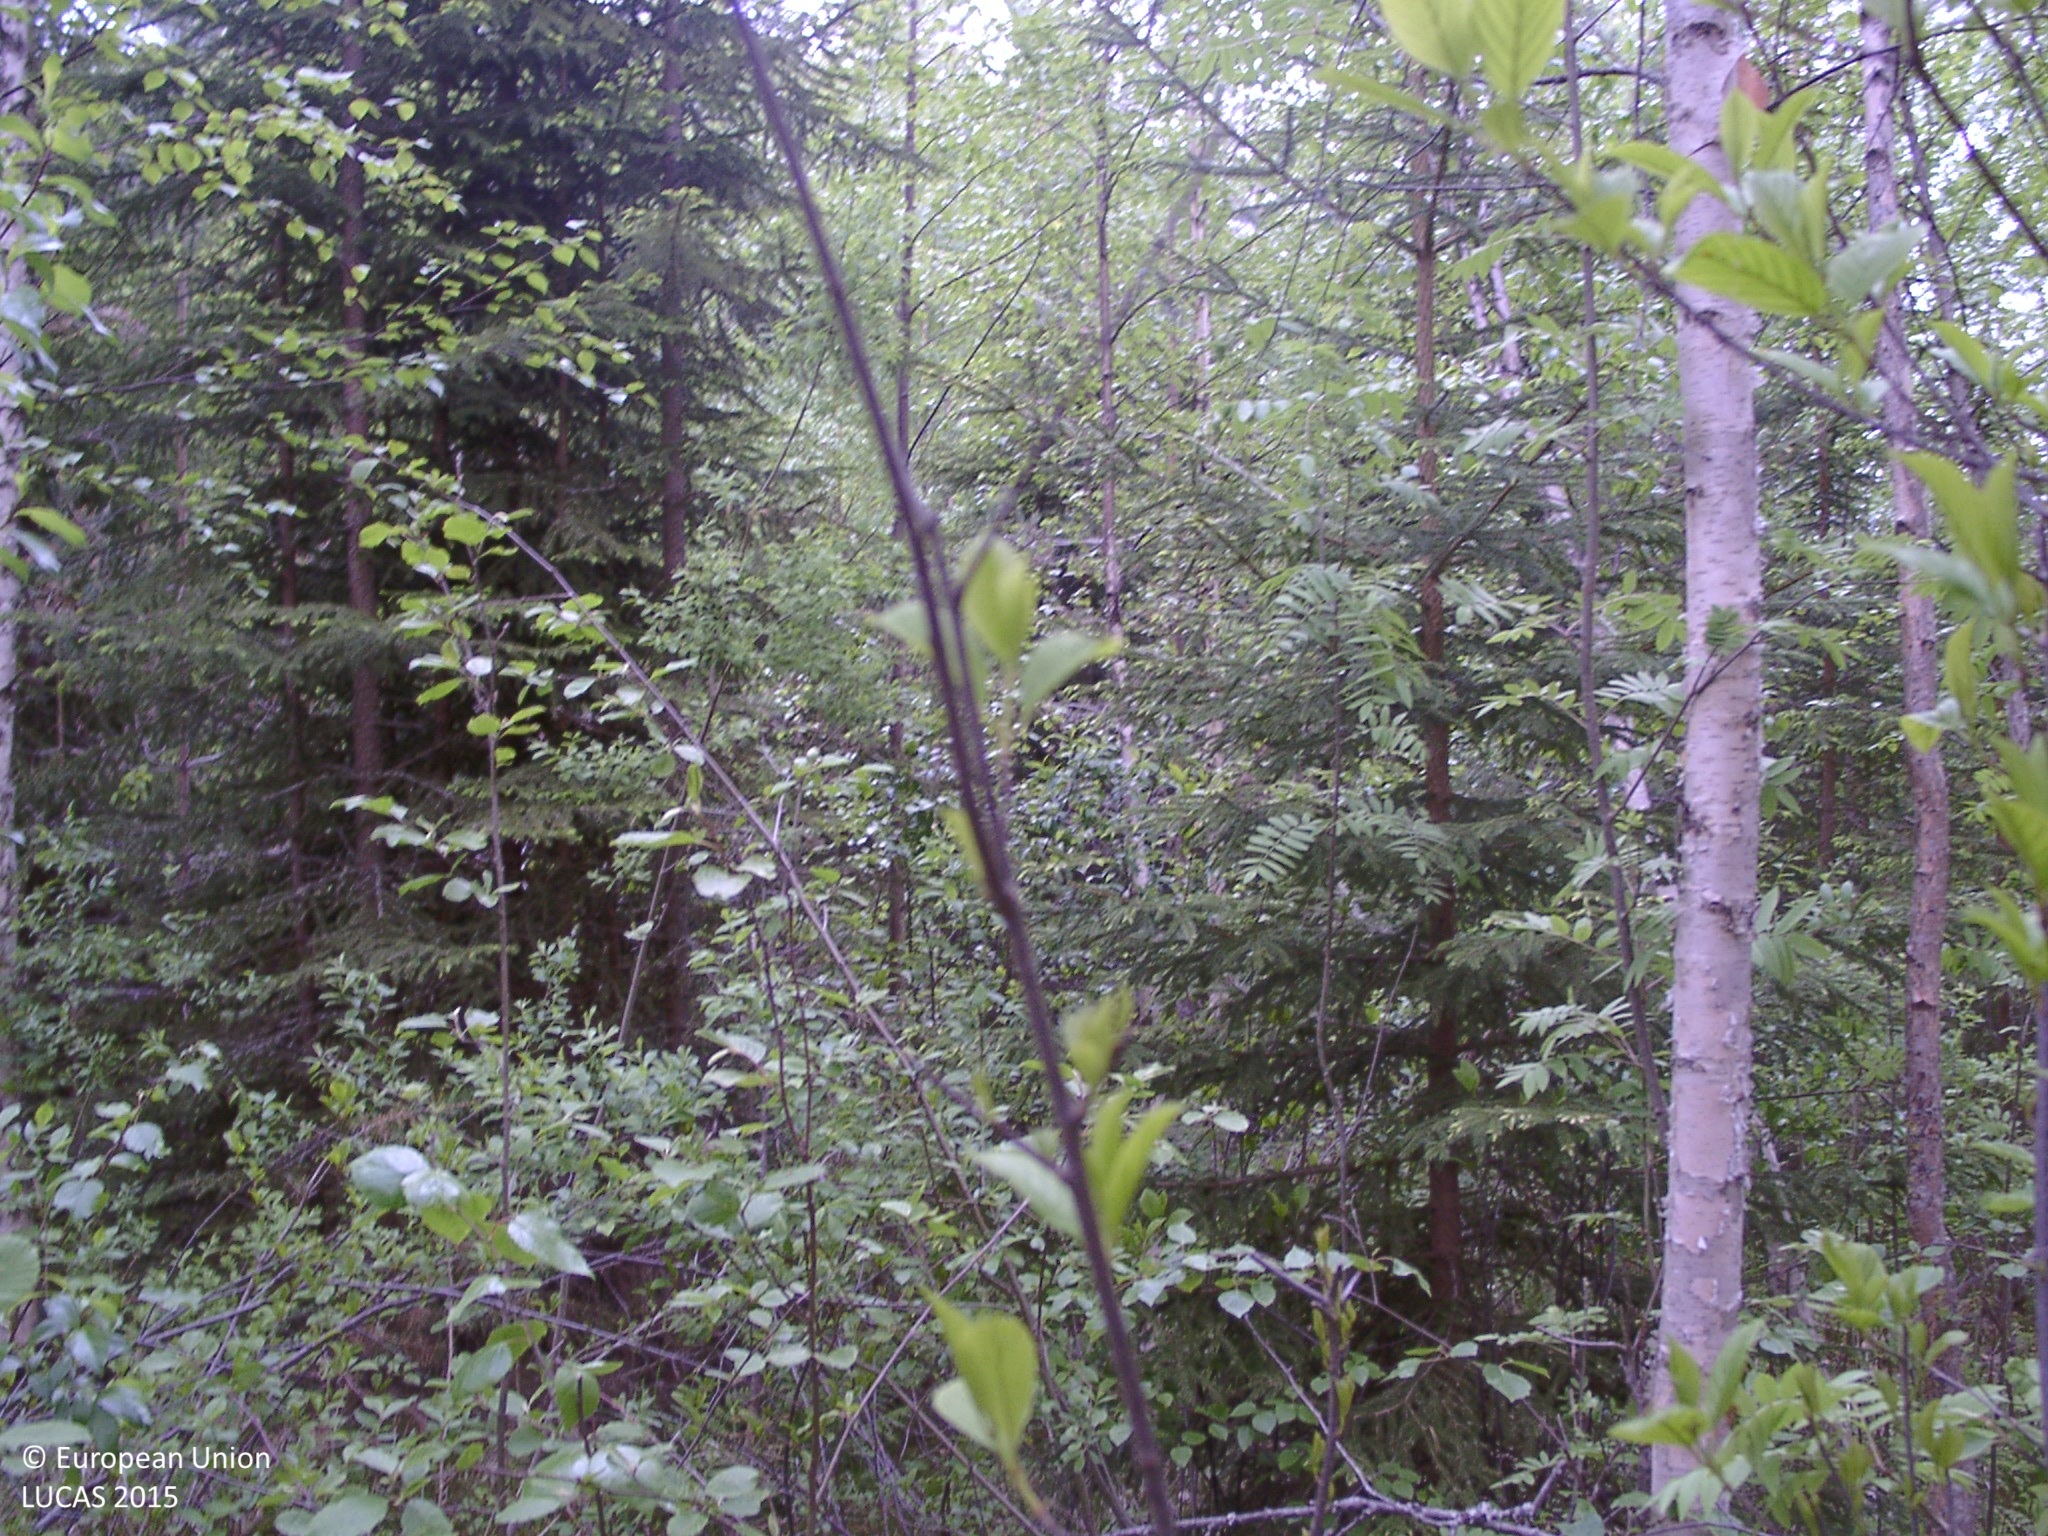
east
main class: Woodland
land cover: Spruce dominated mixed woodland
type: boreal forest
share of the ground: 50 - 75 %
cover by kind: broadleaved forest trees 40 %, shrubs 30 %, coniferous forest trees 20 %, herbaceous plants 5 %, lichens and mosses 5 %
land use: Semi-natural and natural areas not in use
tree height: > 5 m
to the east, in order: Spruce dominated mixed woodland; Ditches and canals; Spruce dominated mixed woodland; Ditches and canals; Spruce dominated mixed woodland; Ditches and canals; Spruce dominated coniferous woodland; Ditches and canals; Other mixed woodland; Pine dominated mixed woodland; Peatbogs; Inland fresh water bodies
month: June
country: FI
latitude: 62.4922
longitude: 25.7805
